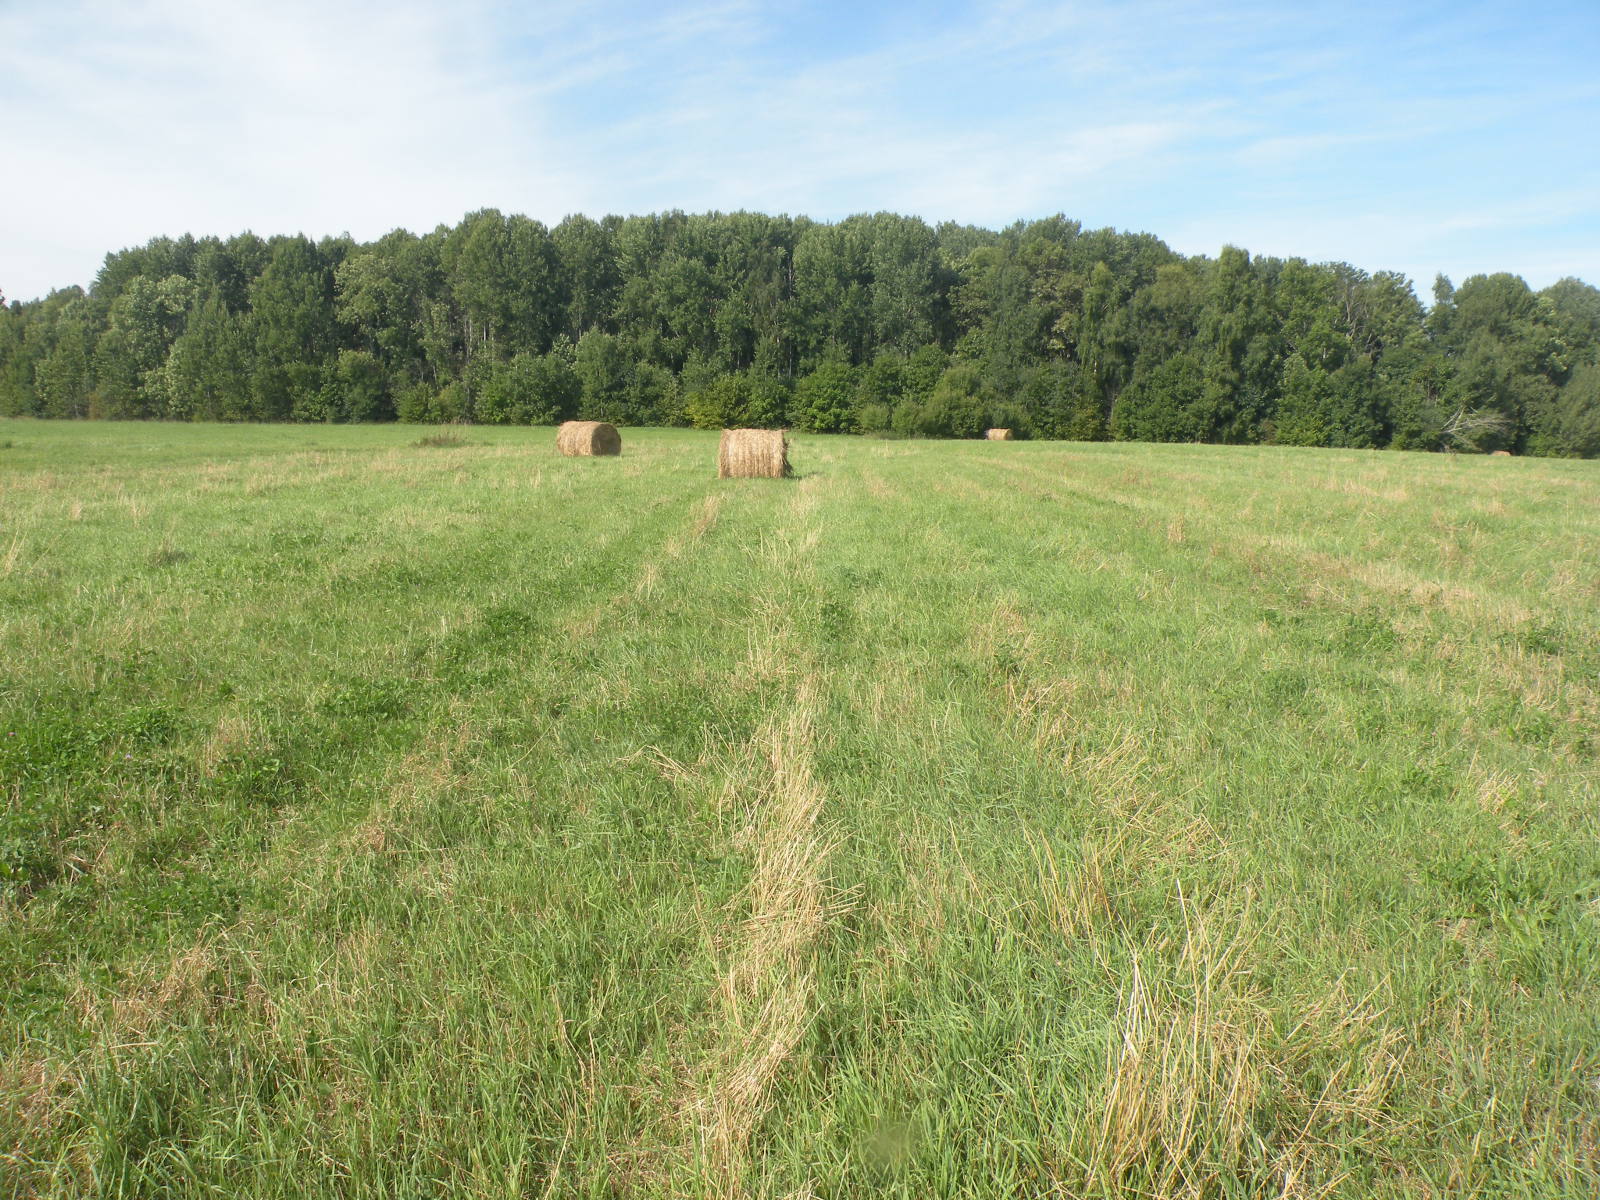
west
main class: Grassland
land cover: Grassland without tree/shrub cover
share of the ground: > 75 %
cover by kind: herbaceous plants 100 %
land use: Agriculture (excluding fallow land and kitchen gardens)
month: August
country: LV
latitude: 55.9387
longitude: 26.1991
